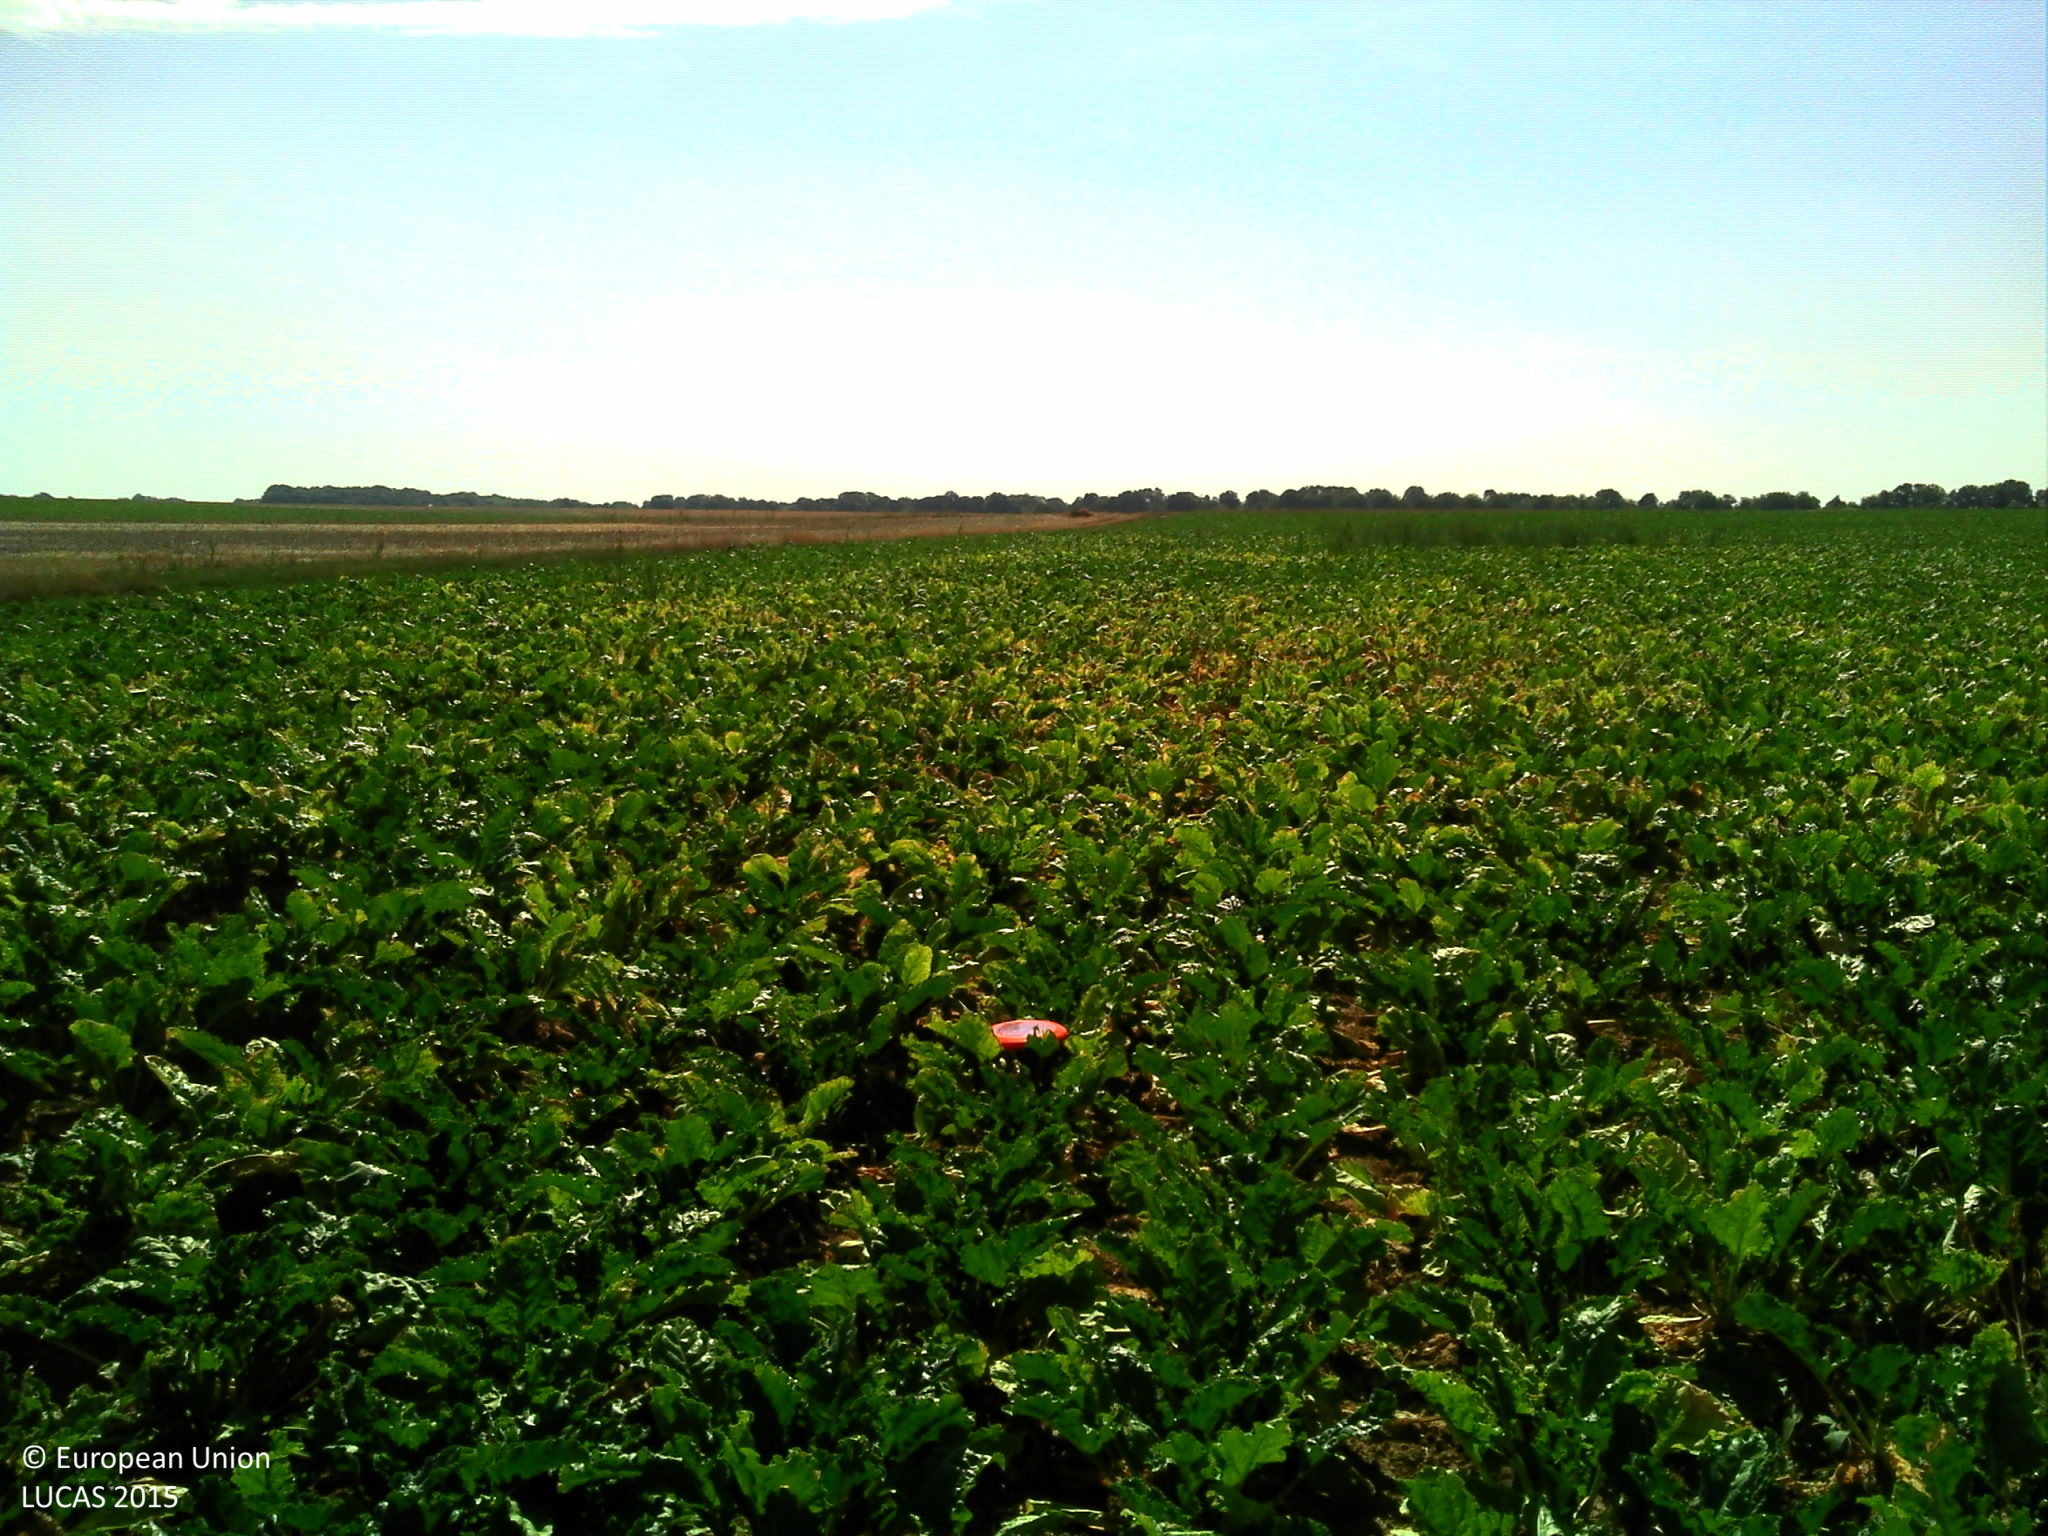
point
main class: Cropland
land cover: Sugar beet
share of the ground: > 75 %
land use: Agriculture (excluding fallow land and kitchen gardens)
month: August
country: FR
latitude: 48.3368
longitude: 2.6110
